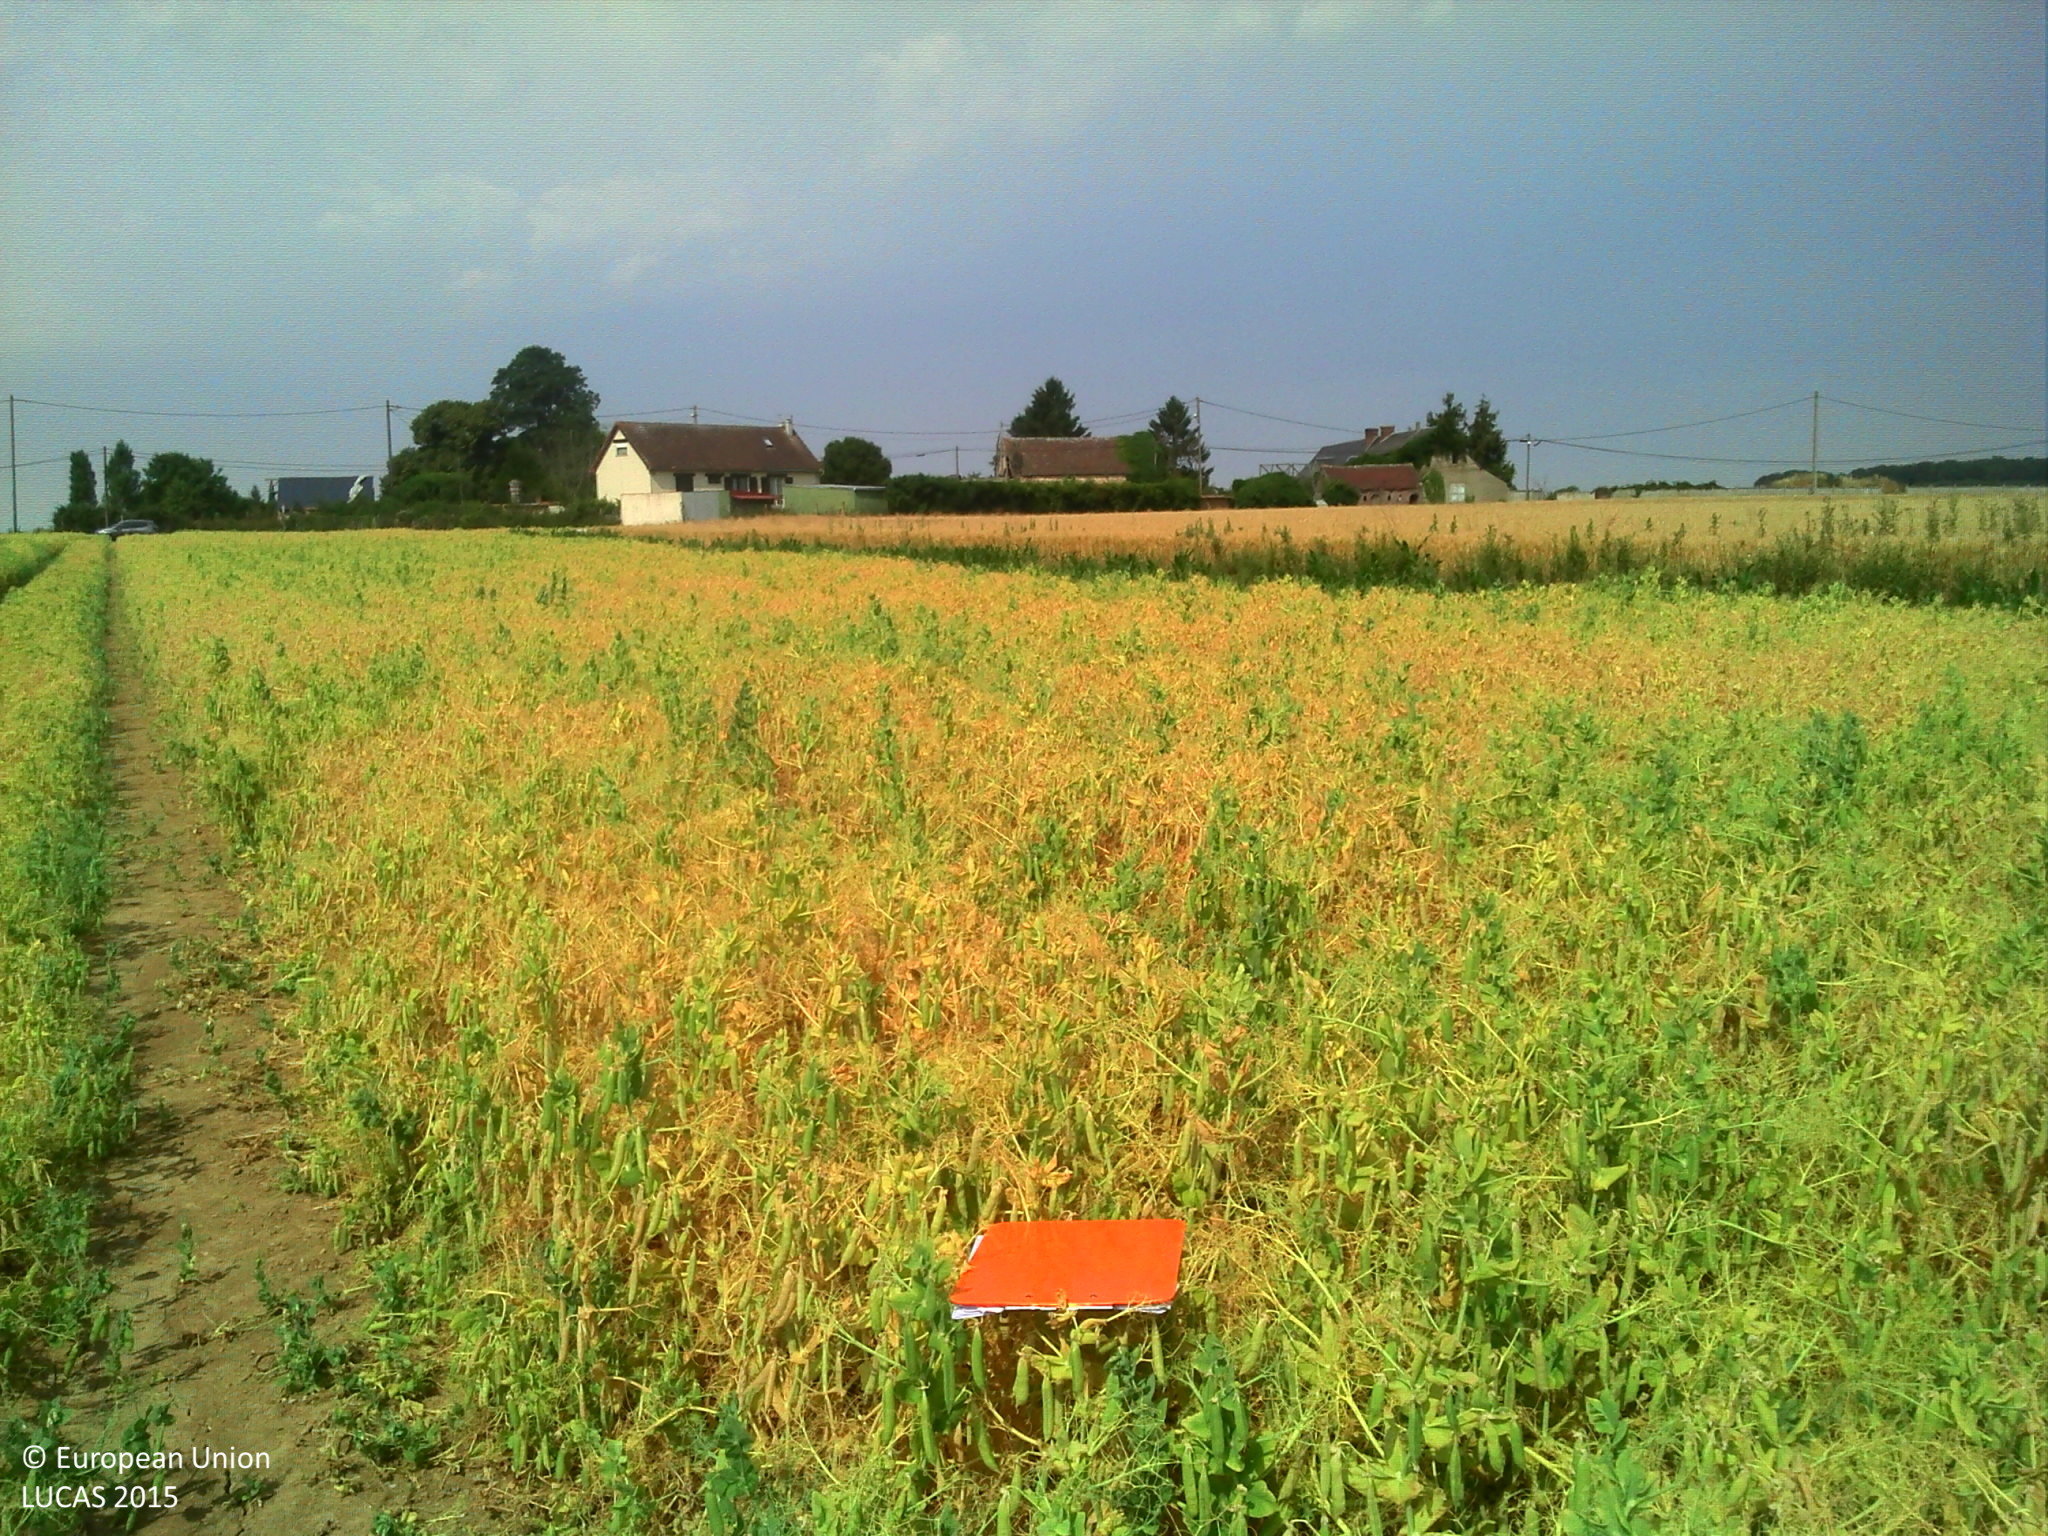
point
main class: Cropland
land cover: Dry pulses
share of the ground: > 75 %
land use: Agriculture (excluding fallow land and kitchen gardens)
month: July
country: FR
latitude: 48.8876
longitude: 1.2384
